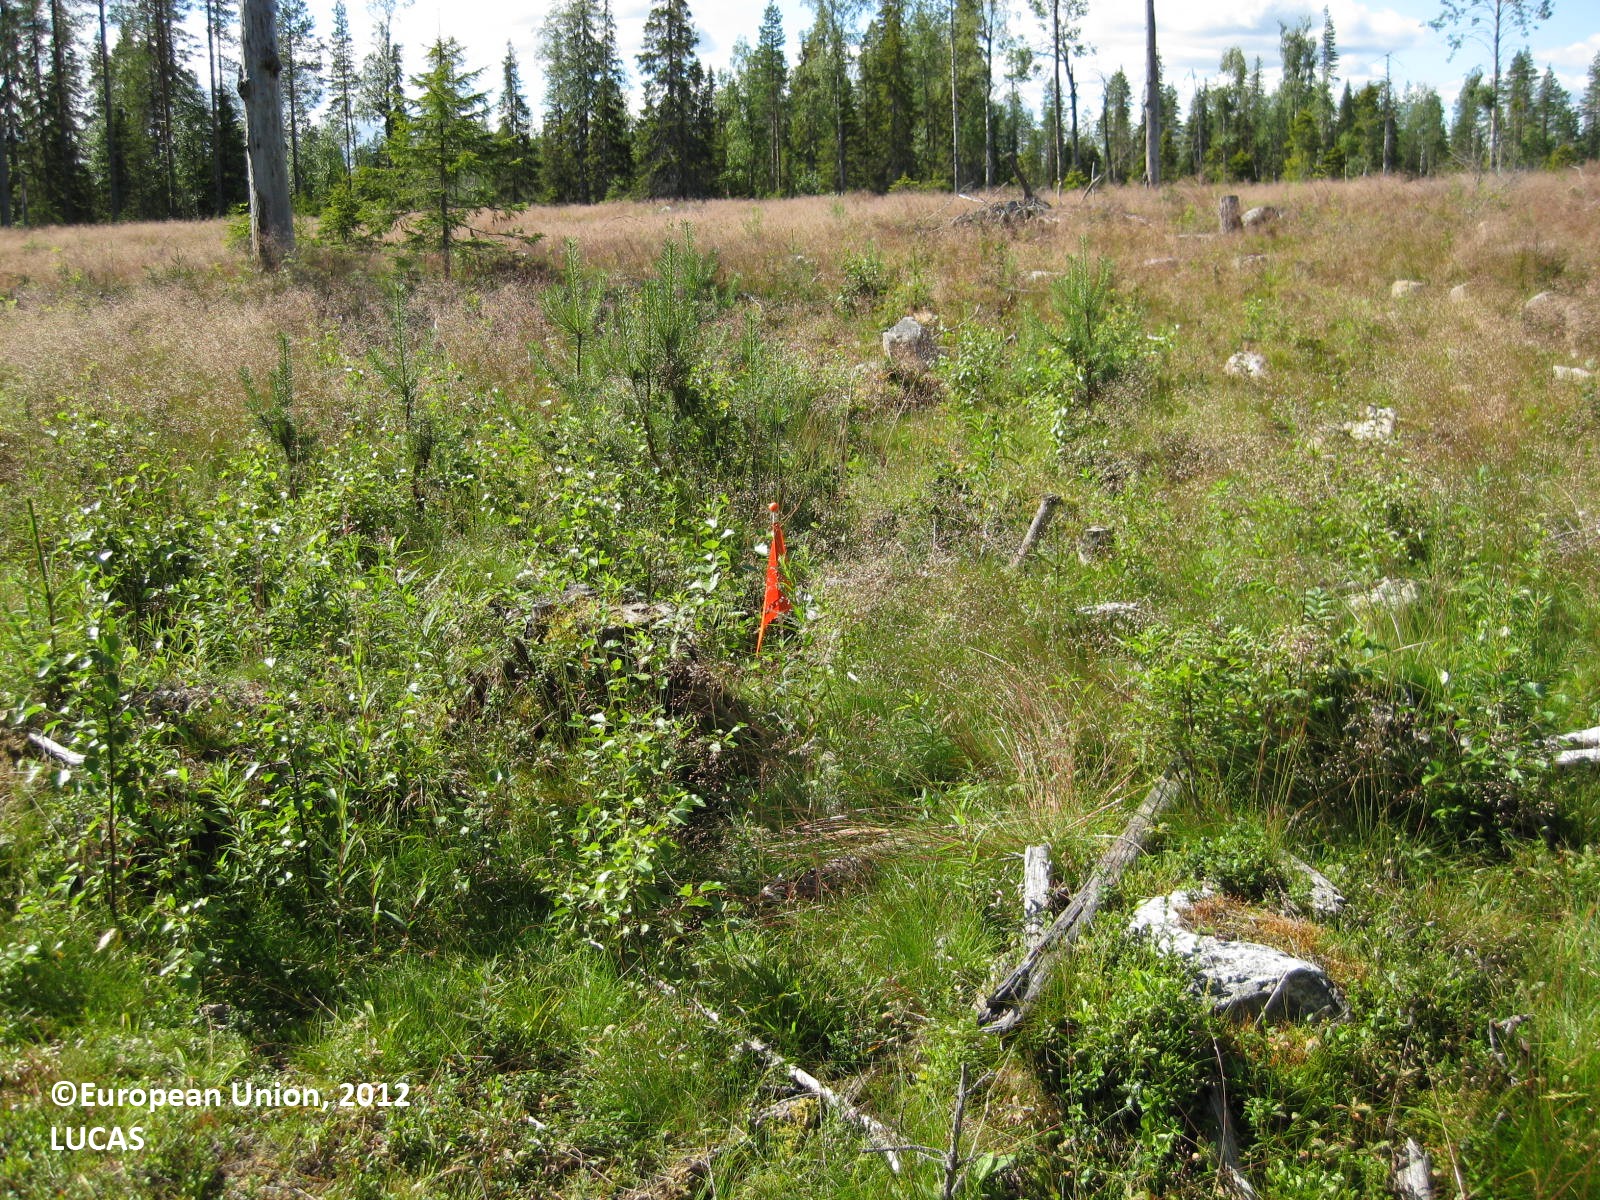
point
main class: Grassland
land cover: Grassland with sparse tree/shrub cover
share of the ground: > 75 %
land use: Forestry
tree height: < 5 m
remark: Clear cut
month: July
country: FI
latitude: 65.6830
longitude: 28.3705
